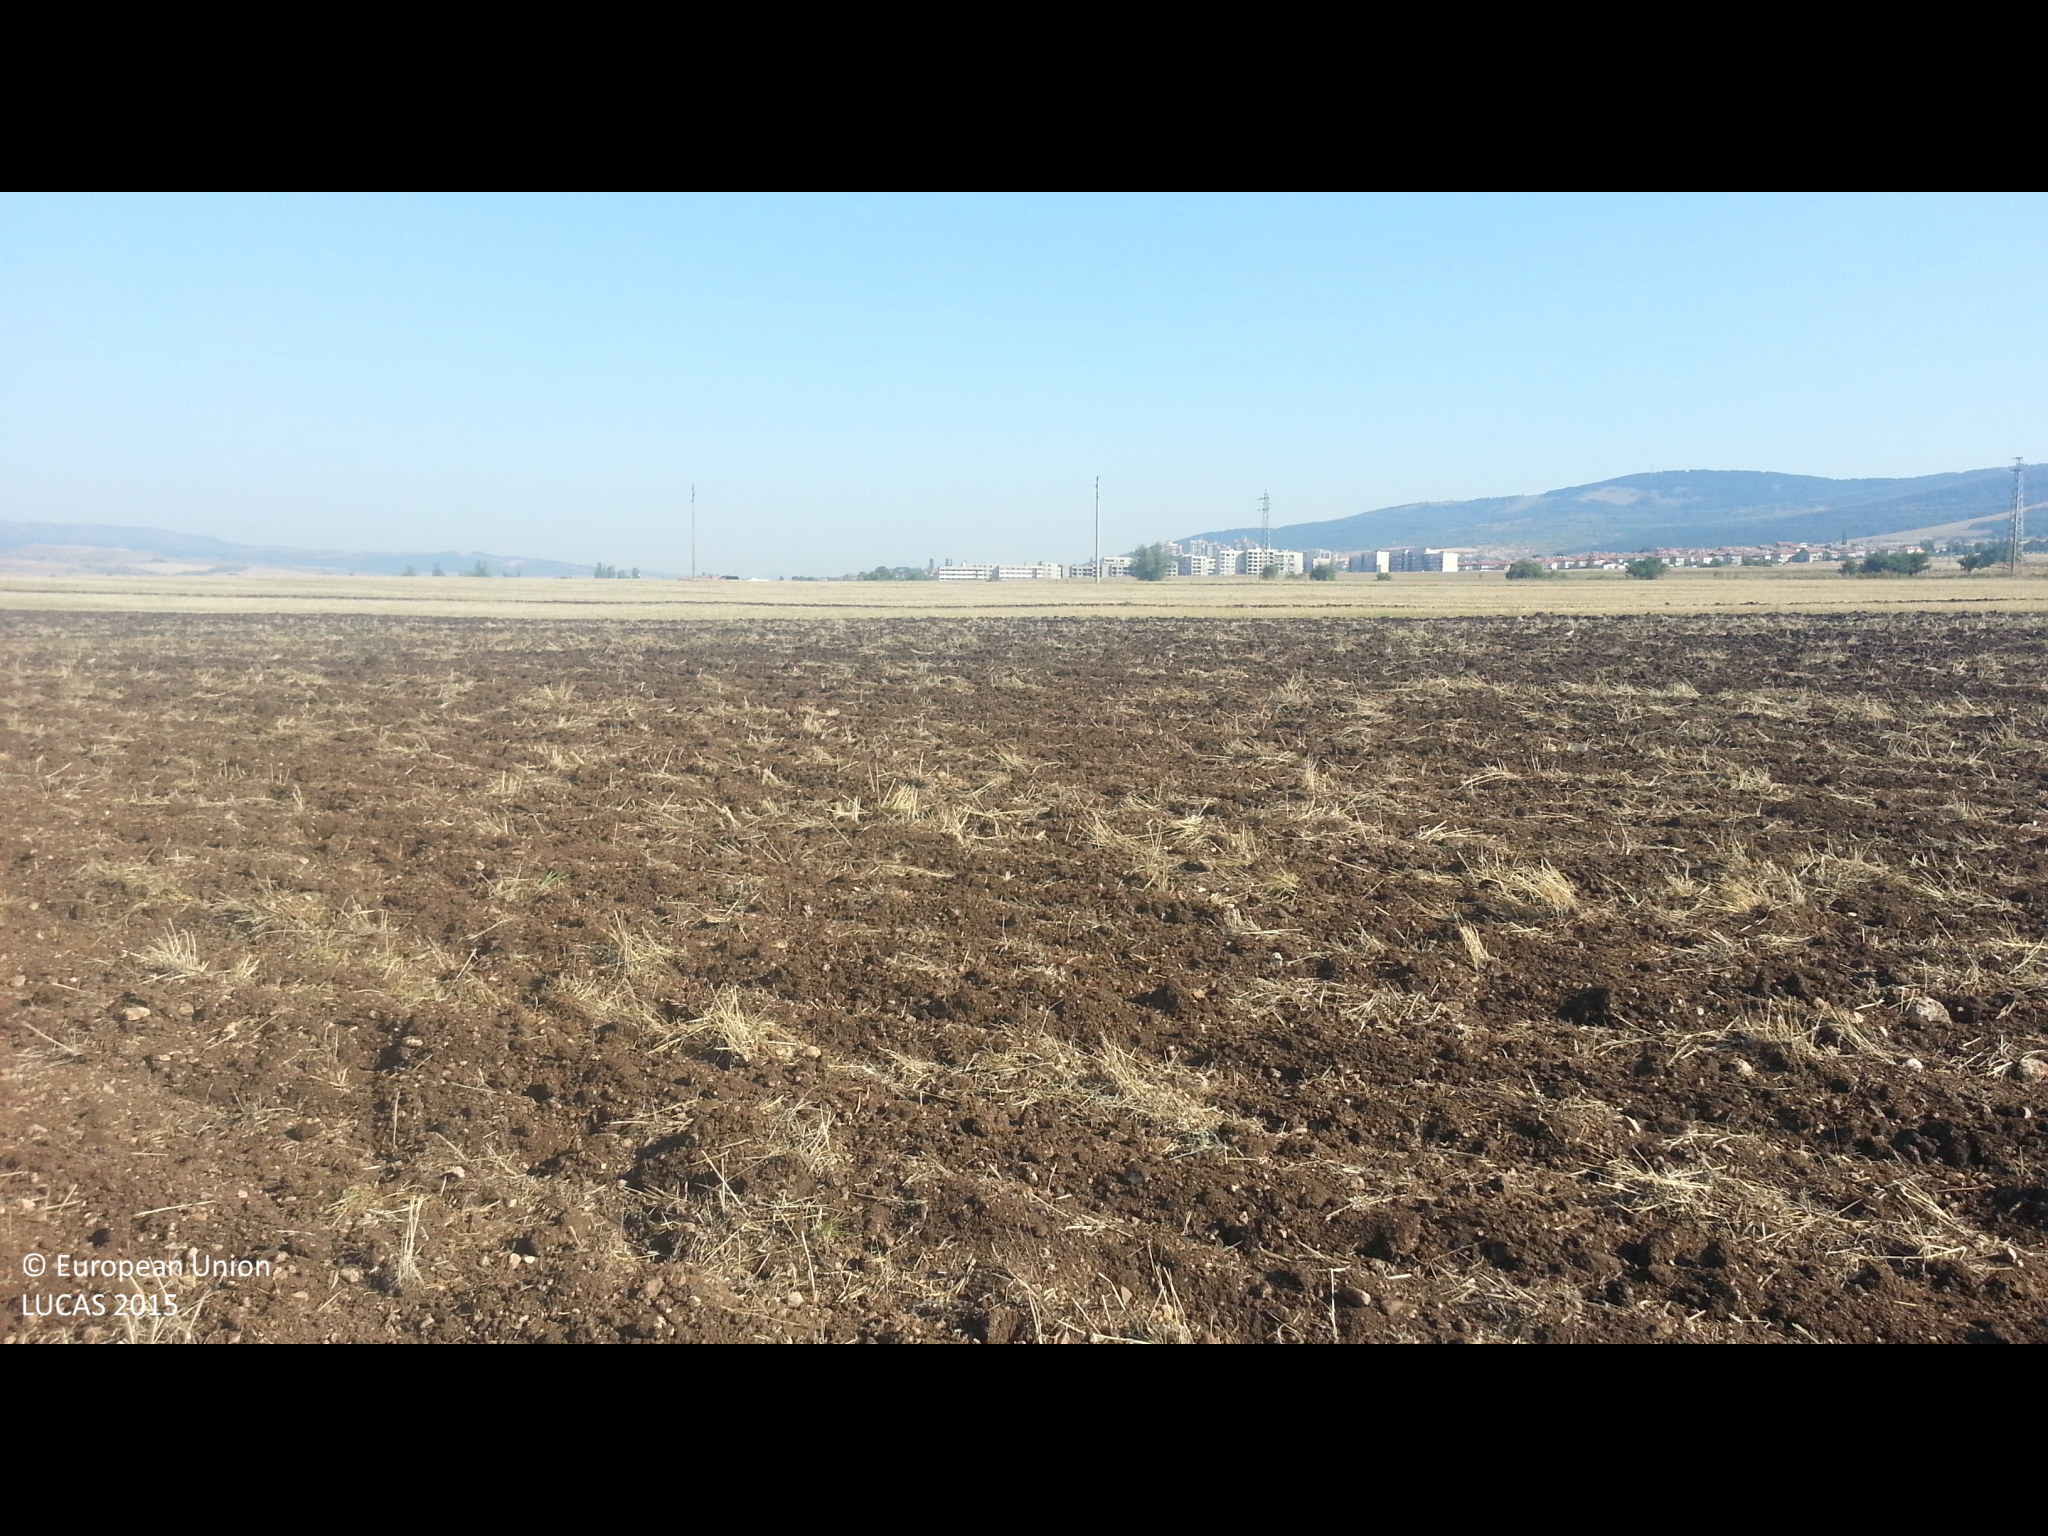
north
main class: Cropland
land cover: Common wheat
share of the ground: < 10 %
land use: Agriculture (excluding fallow land and kitchen gardens)
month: August
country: BG
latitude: 42.5287
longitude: 22.9688
